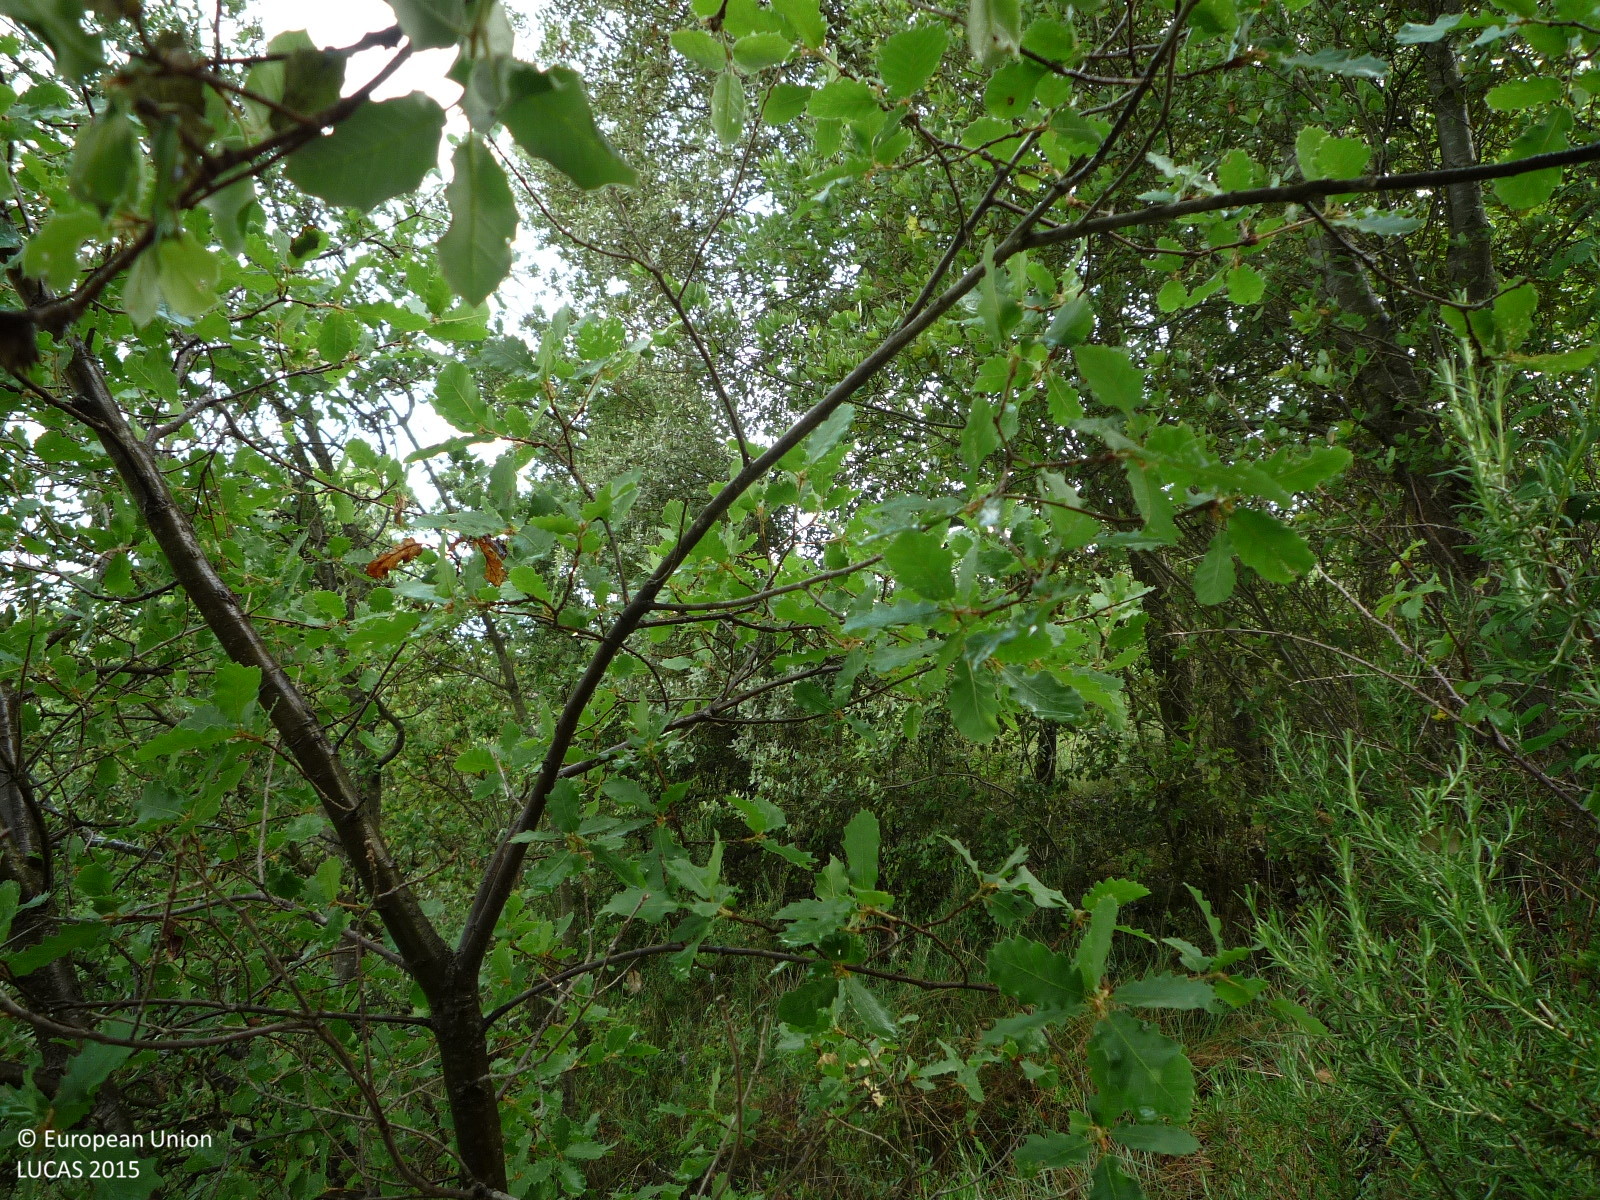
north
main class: Woodland
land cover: Broadleaved woodland
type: broadleaved evergreen forest
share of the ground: > 75 %
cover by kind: broadleaved forest trees 80 %, shrubs 20 %
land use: Semi-natural and natural areas not in use
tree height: < 5 m
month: June
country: ES
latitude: 42.0055
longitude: 1.9363
